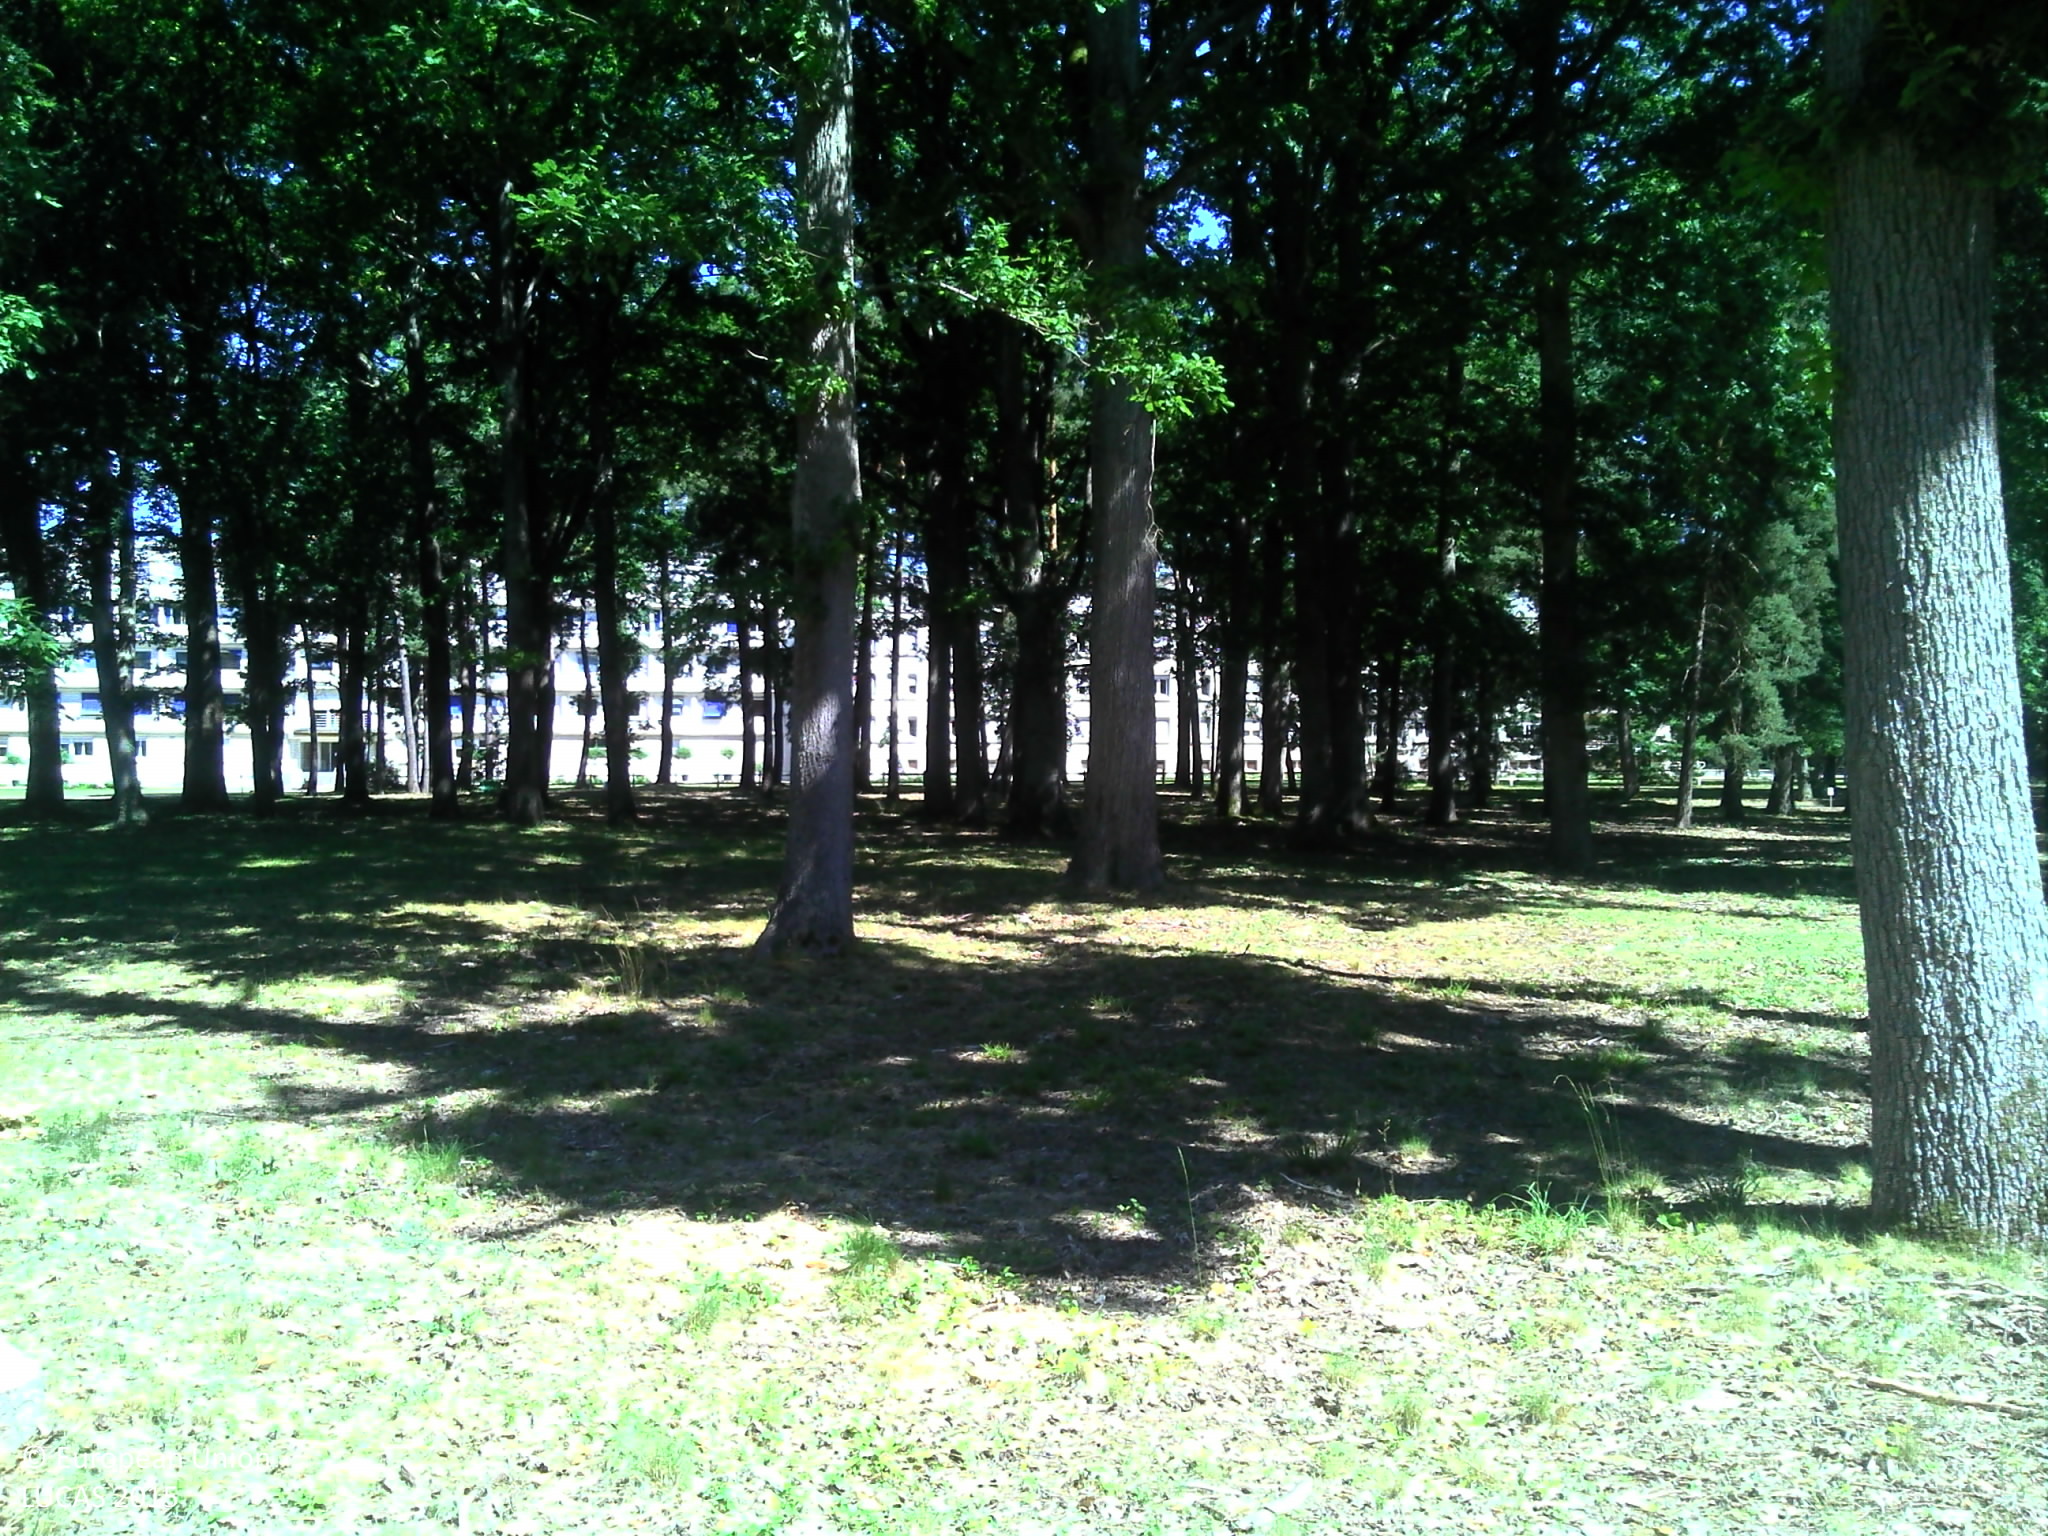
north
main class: Woodland
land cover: Broadleaved woodland
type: mesophytic deciduous forest
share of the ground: > 75 %
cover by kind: broadleaved forest trees 80 %, herbaceous plants 20 %
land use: Community services
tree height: > 5 m
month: June
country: FR
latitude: 49.0017
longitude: 1.0803
